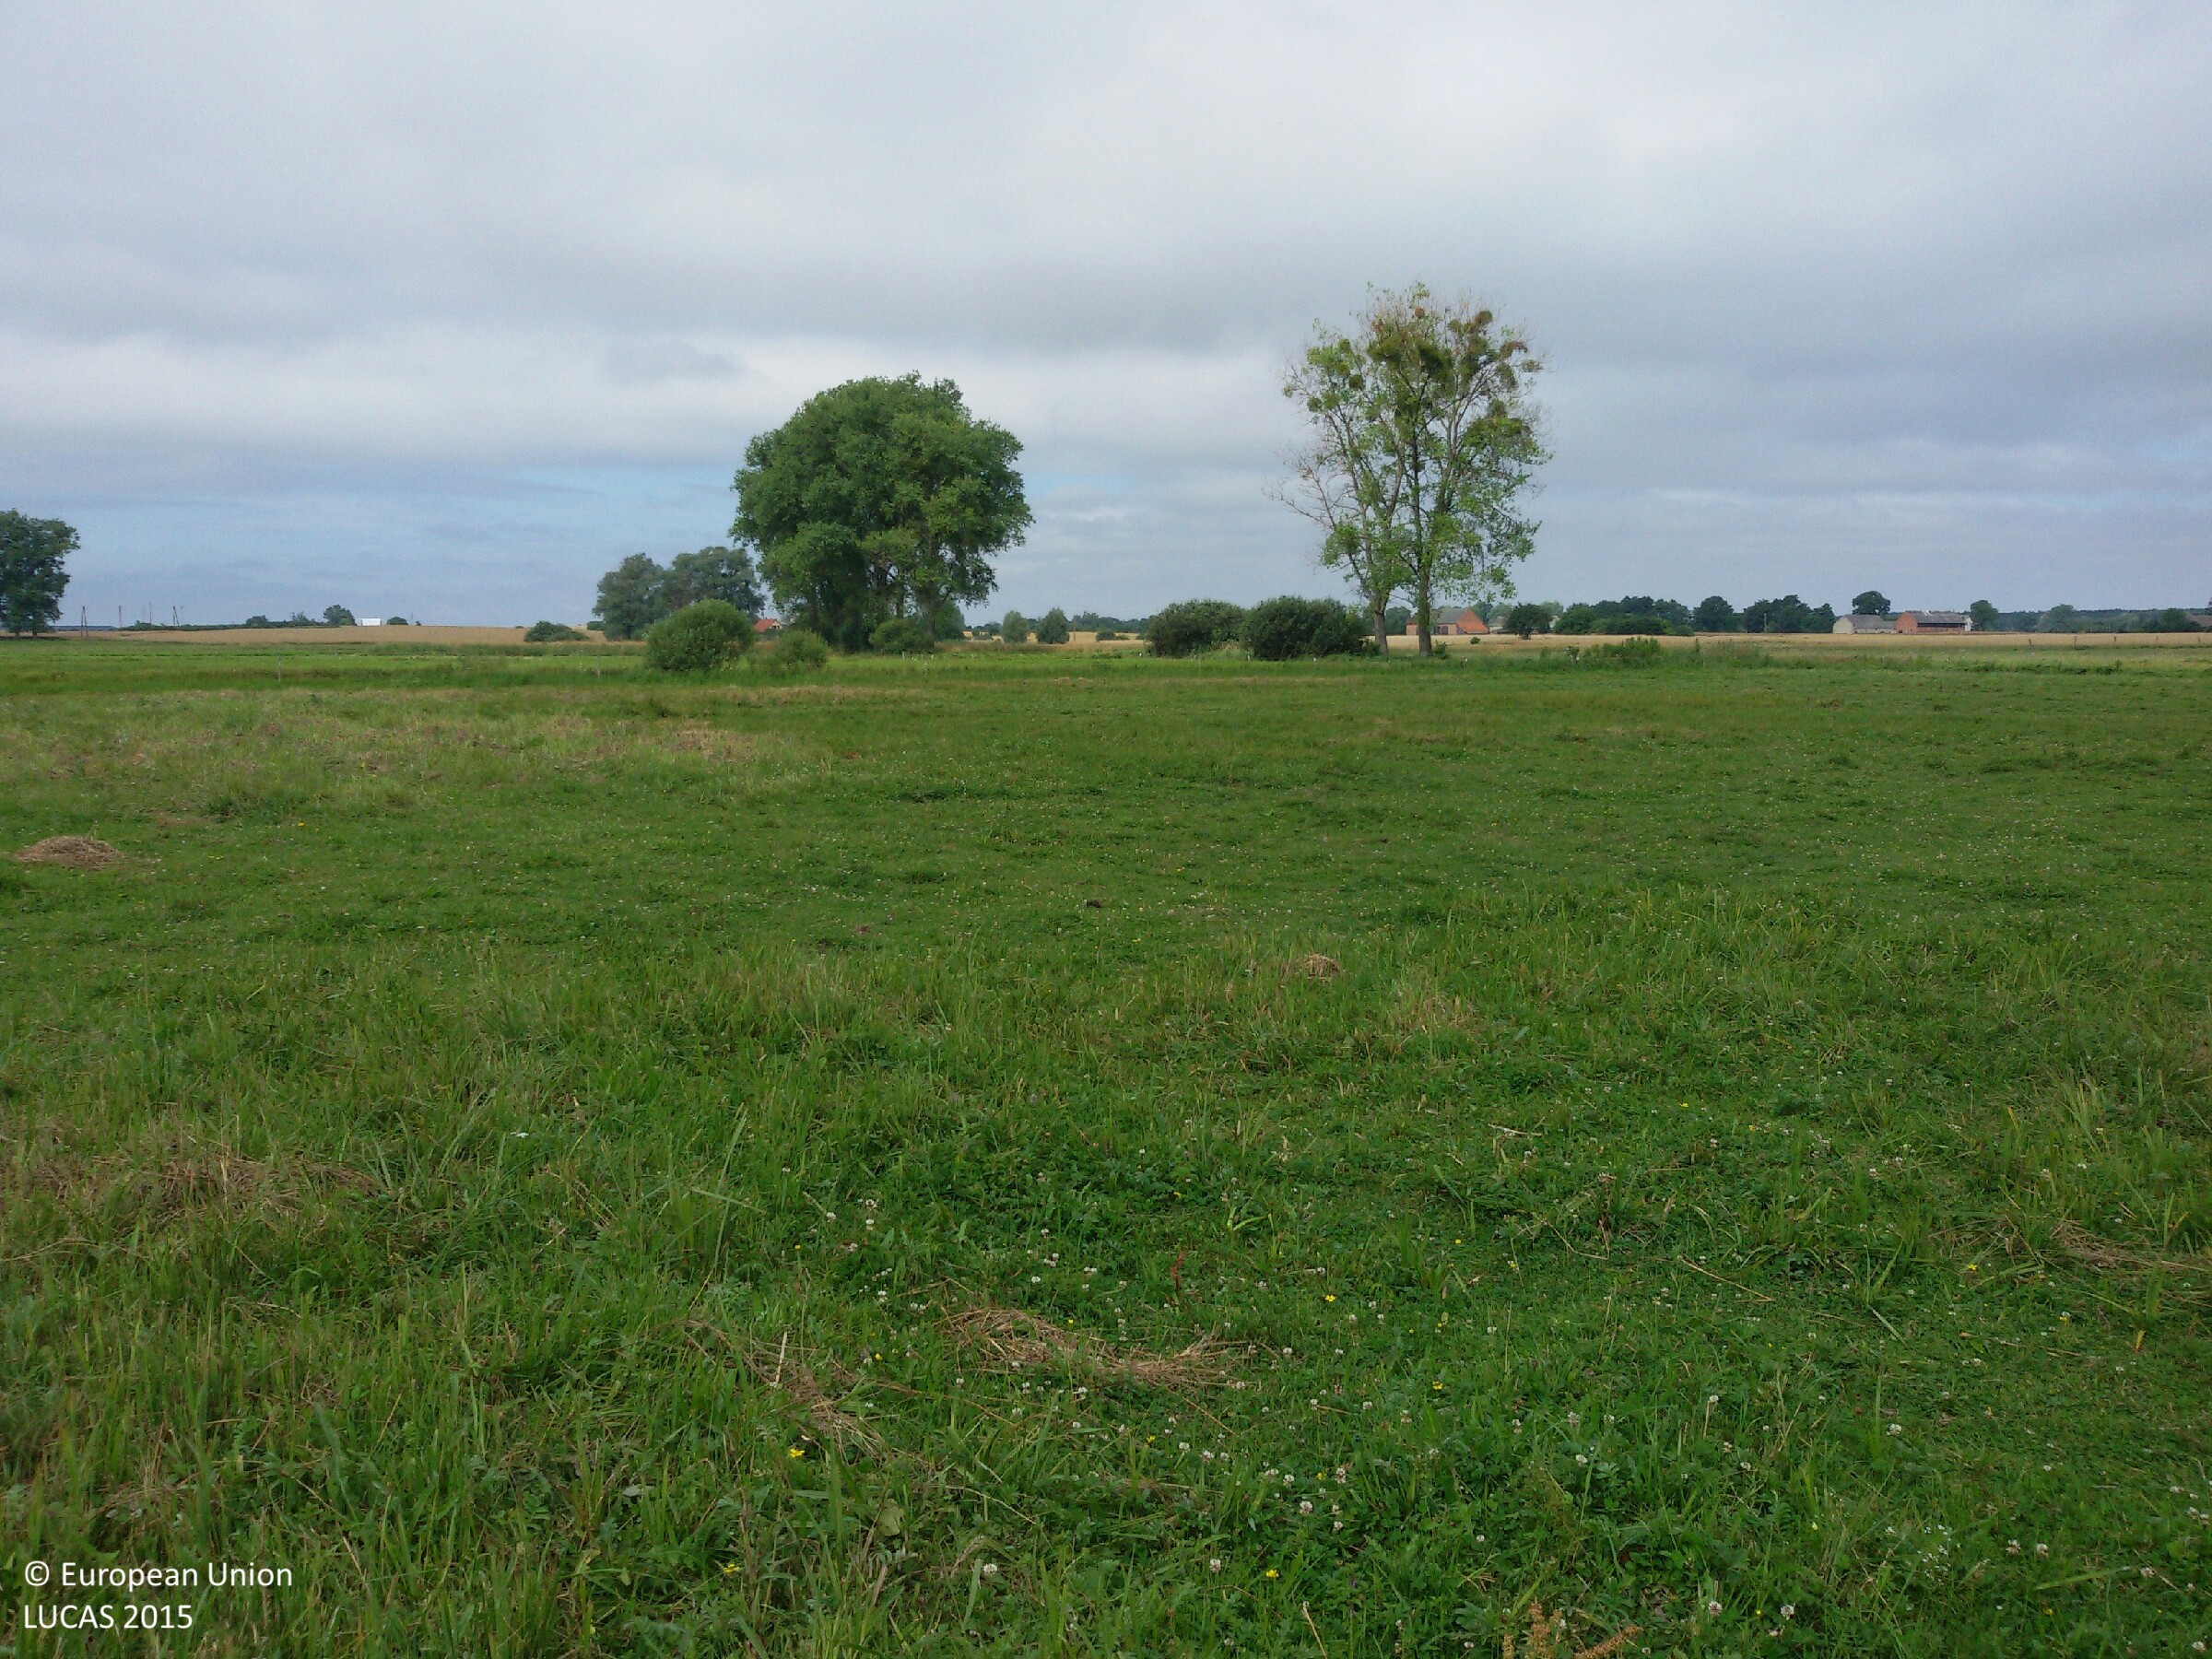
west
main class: Grassland
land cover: Grassland without tree/shrub cover
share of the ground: > 75 %
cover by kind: herbaceous plants 100 %
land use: Agriculture (excluding fallow land and kitchen gardens)
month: July
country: PL
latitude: 53.0507
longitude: 15.7179
